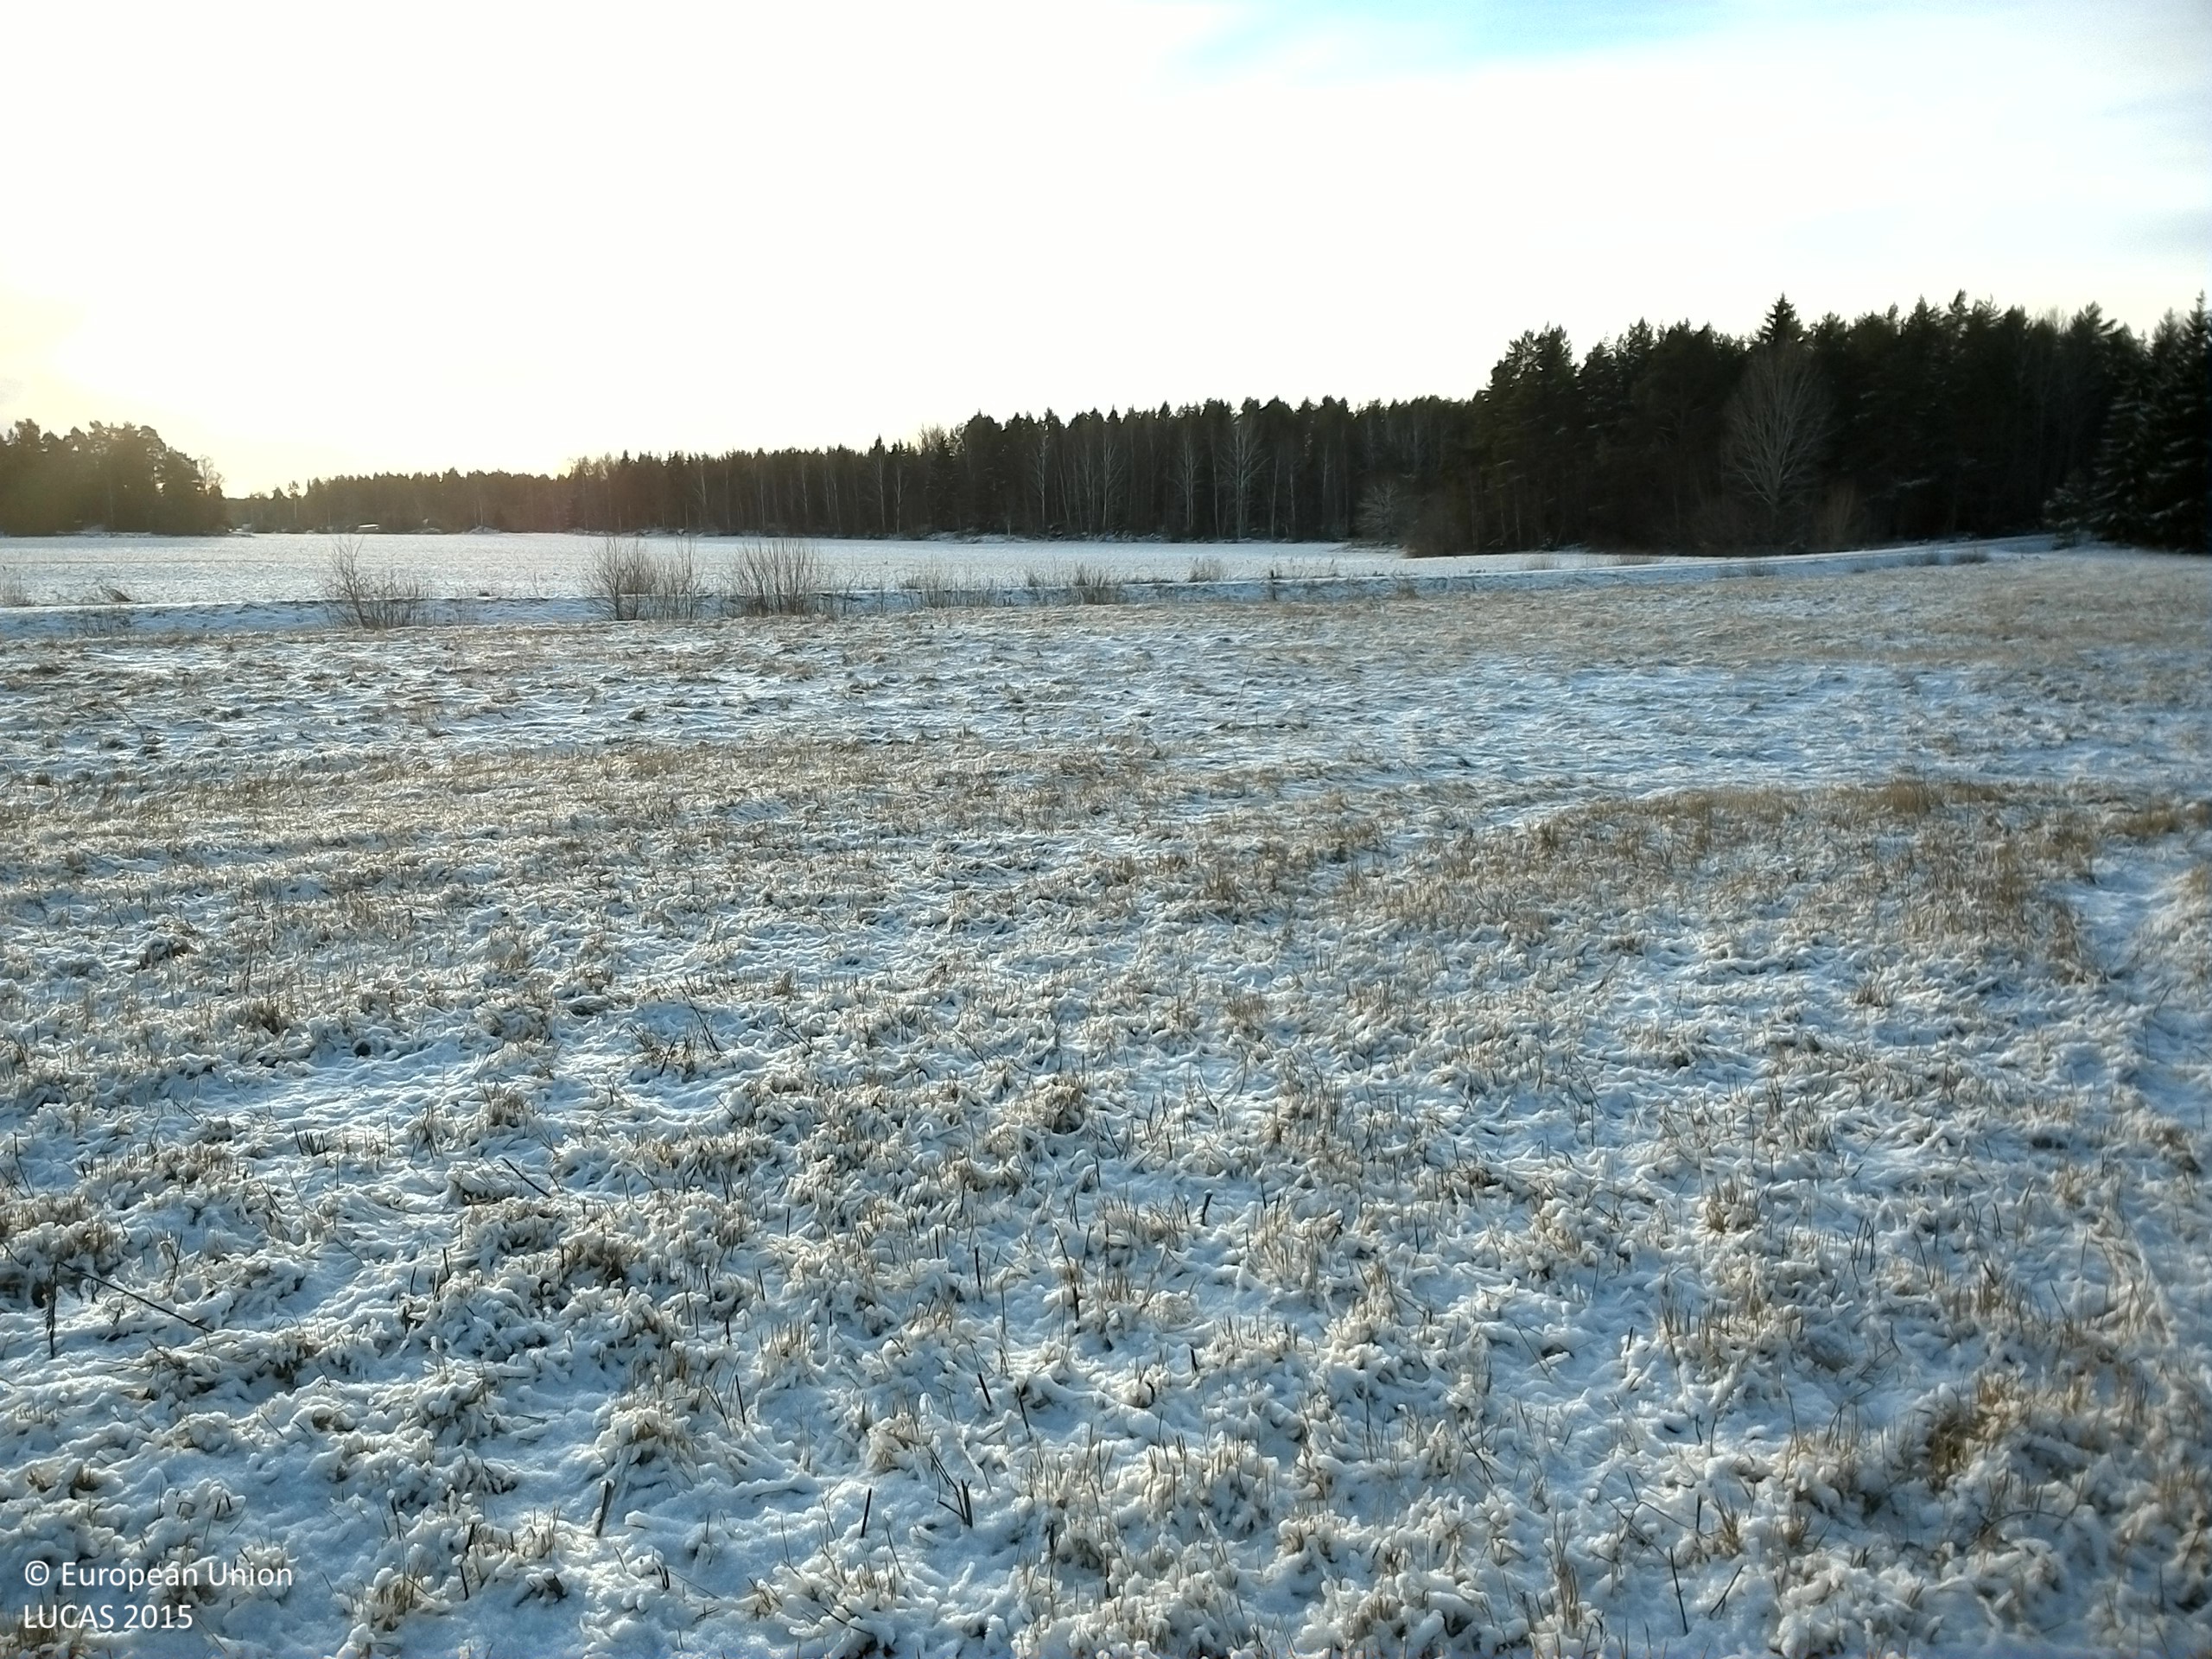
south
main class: Grassland
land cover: Grassland without tree/shrub cover
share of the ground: > 75 %
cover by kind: herbaceous plants 100 %
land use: Agriculture (excluding fallow land and kitchen gardens)
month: December
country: SE
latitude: 59.5666
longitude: 16.3814
